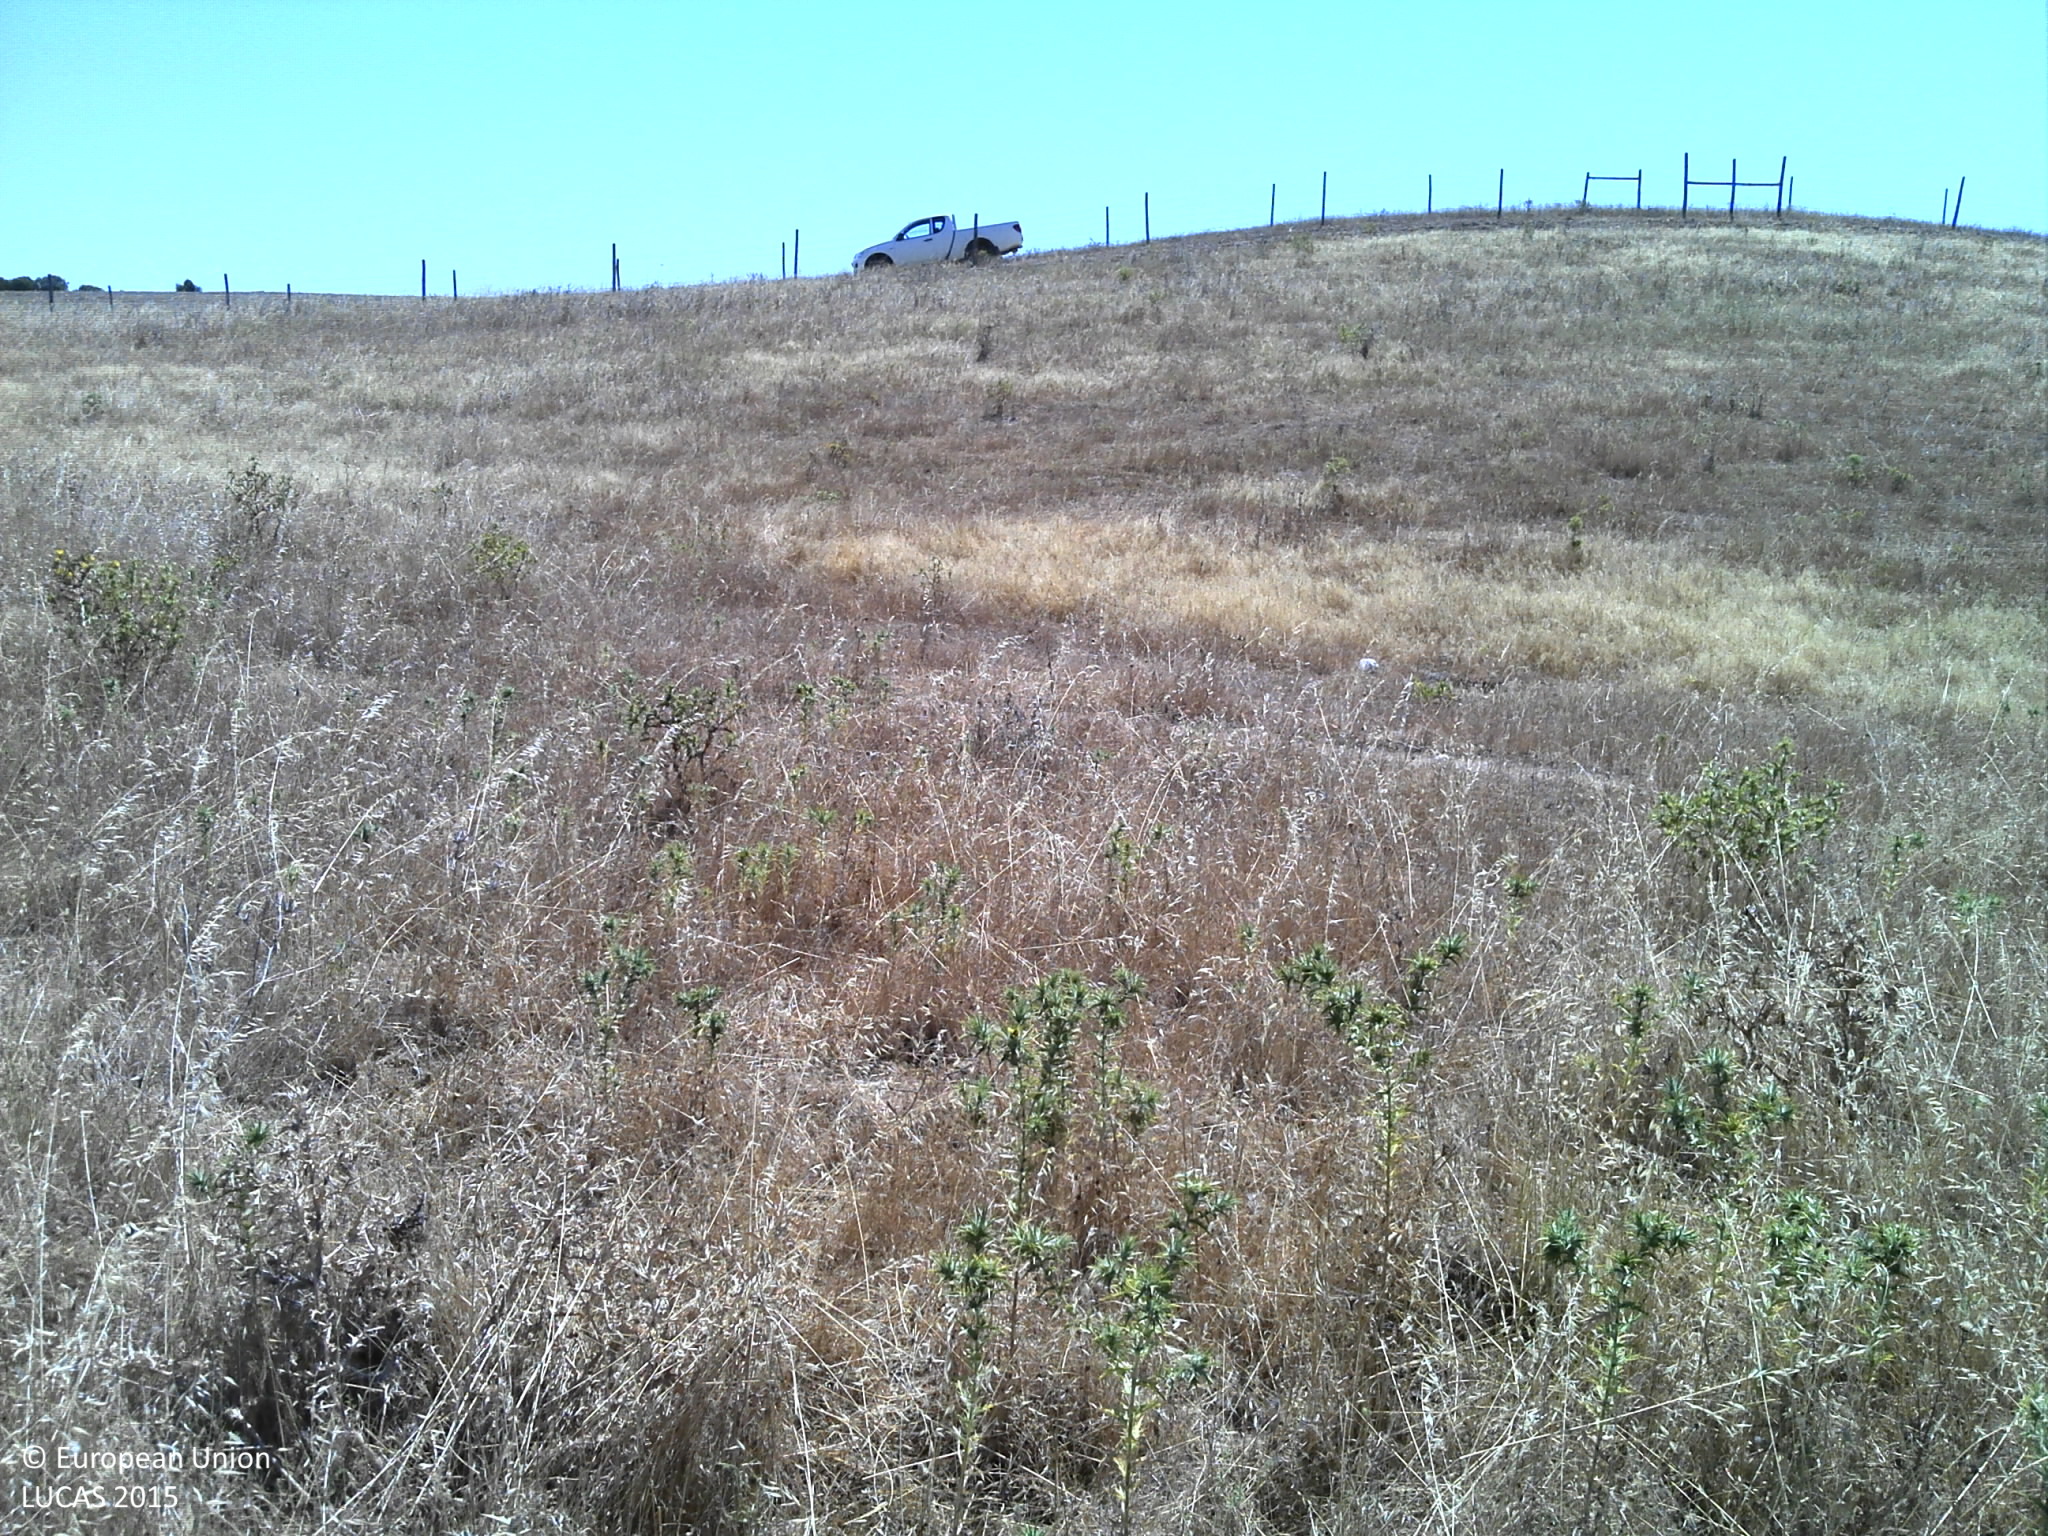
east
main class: Grassland
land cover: Grassland without tree/shrub cover
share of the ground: 50 - 75 %
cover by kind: herbaceous plants 70 %, unconsolidated bare surface 30 %
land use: Agriculture (excluding fallow land and kitchen gardens)
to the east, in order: Grassland without tree/shrub cover; Other structural elements; Fences; Tracks; Fences; Grassland without tree/shrub cover; Fences; Grassland without tree/shrub cover
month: June
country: PT
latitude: 37.7883
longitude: -8.3045
